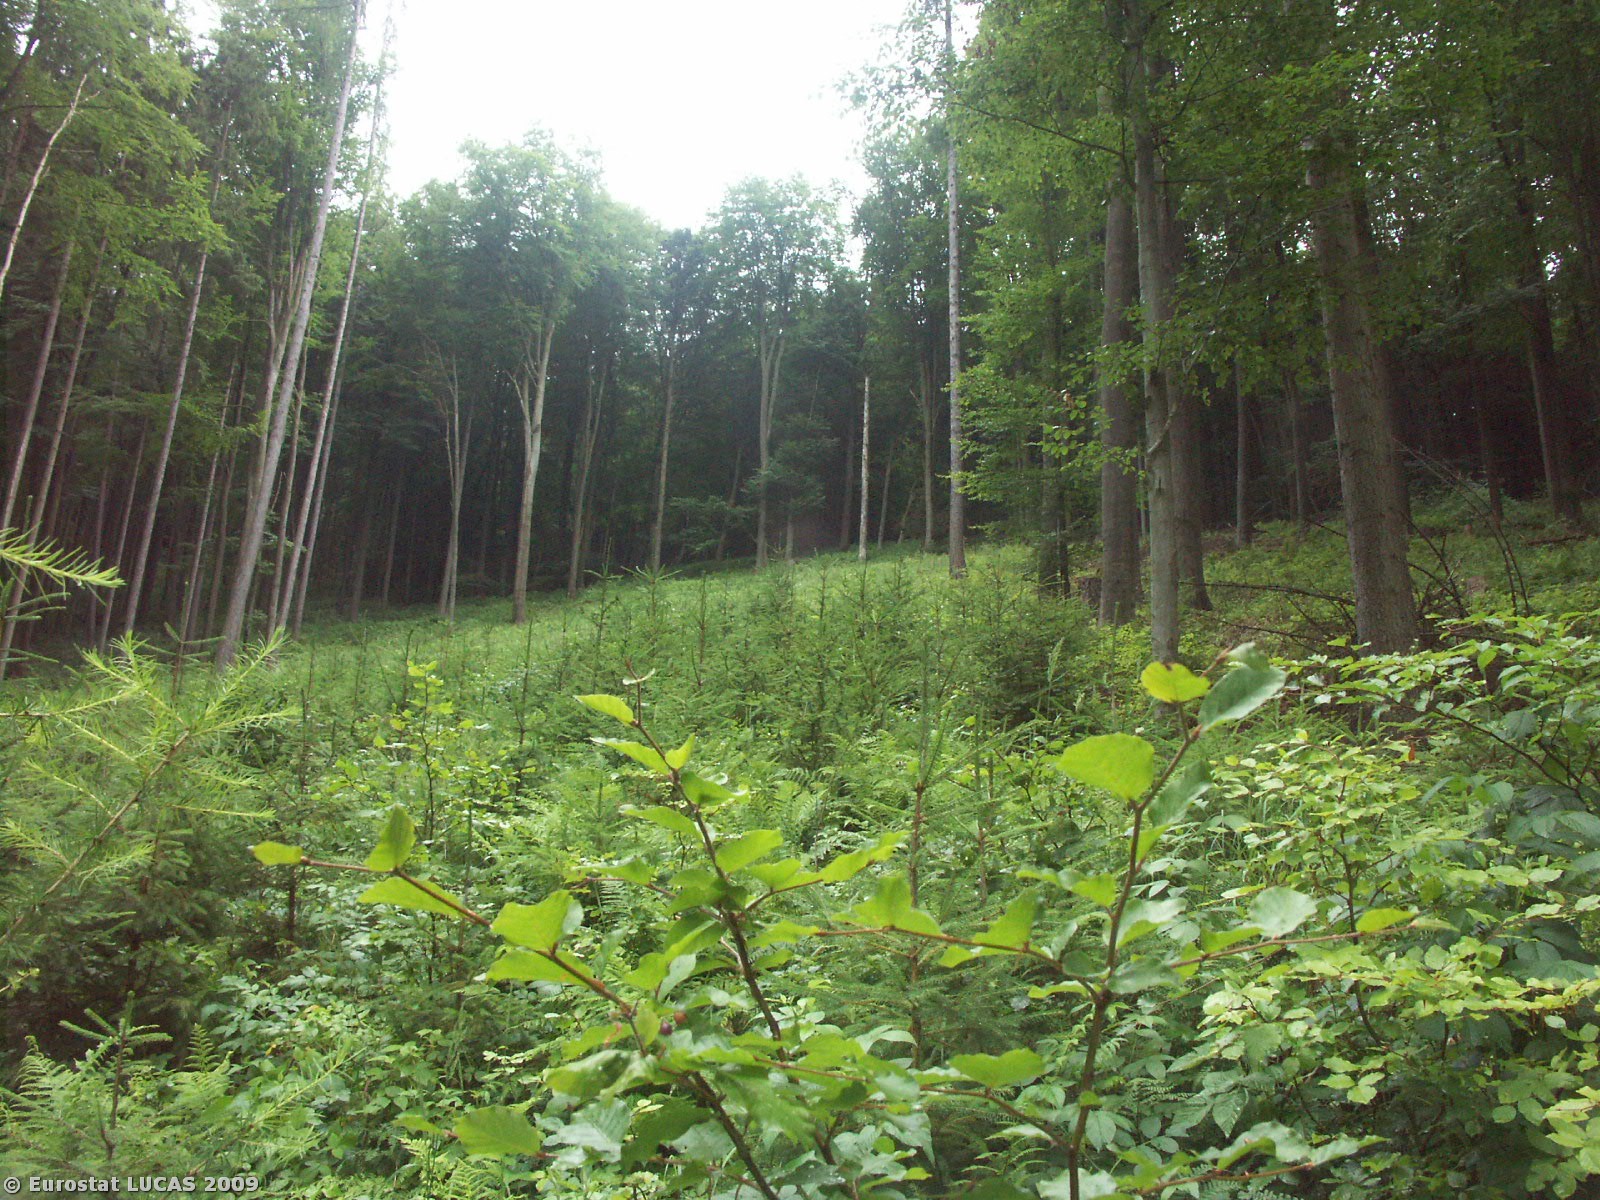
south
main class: Woodland
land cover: Mixed woodland
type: hemiboreal forest and nemoral coniferous forest and mixed broadleaved-coniferous forest
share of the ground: 50 - 75 %
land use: Forestry
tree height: > 5 m
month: July
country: CZ
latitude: 49.8678
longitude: 17.1757
